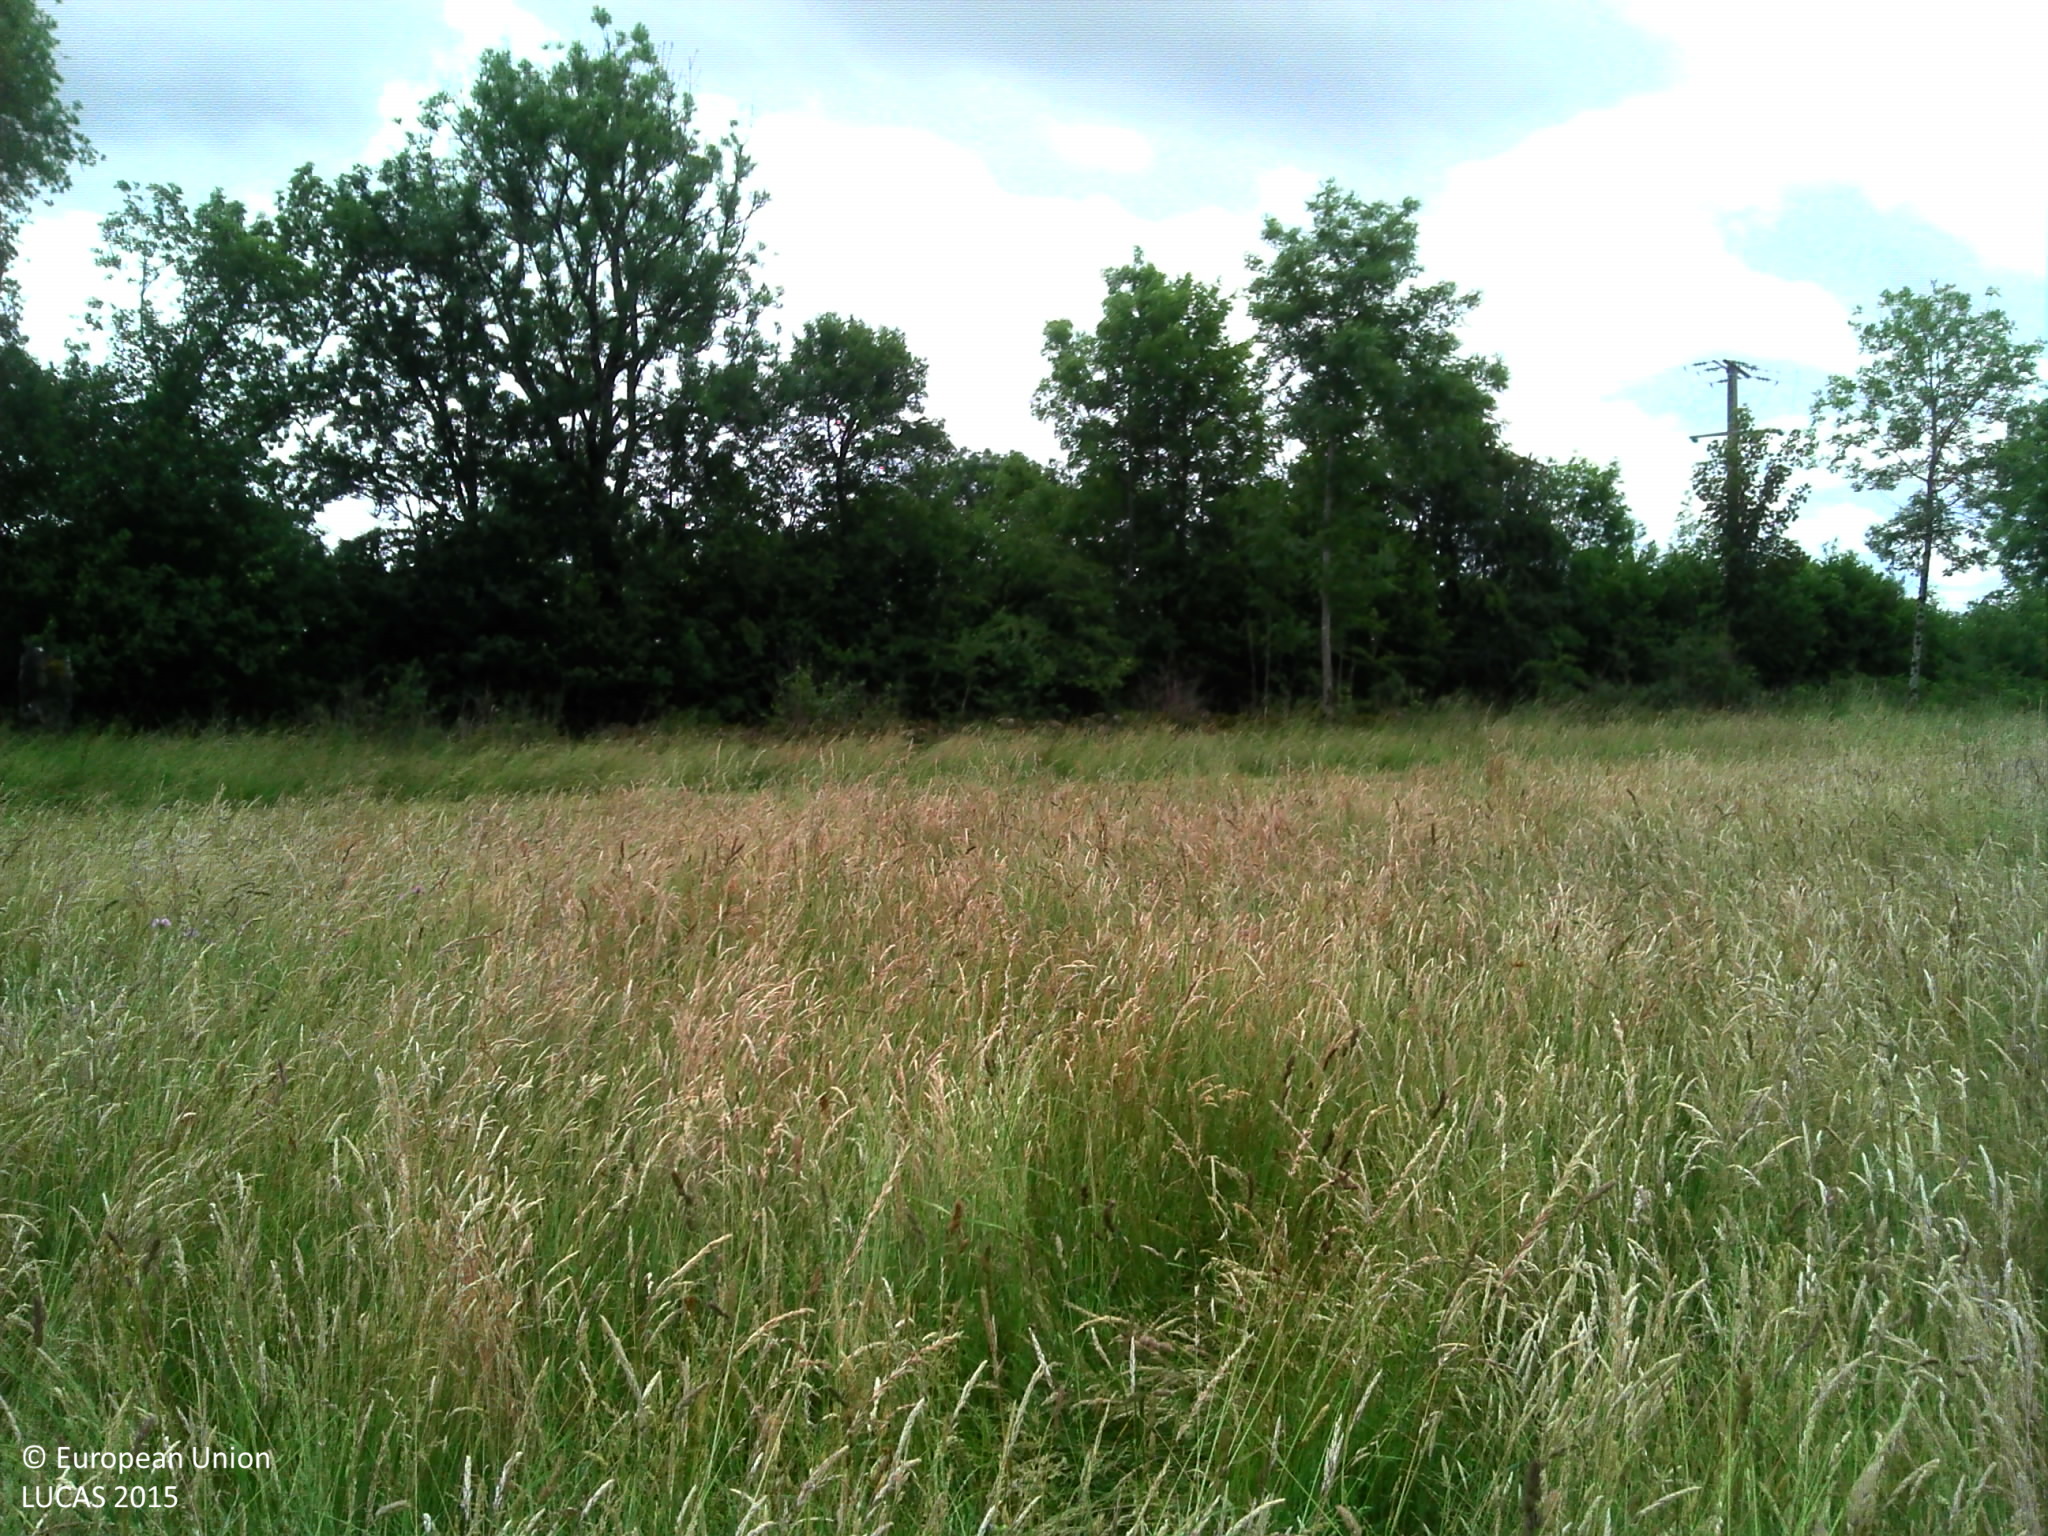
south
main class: Grassland
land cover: Grassland without tree/shrub cover
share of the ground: > 75 %
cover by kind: herbaceous plants 100 %
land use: Agriculture (excluding fallow land and kitchen gardens)
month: June
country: FR
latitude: 45.1904
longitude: 2.3495
